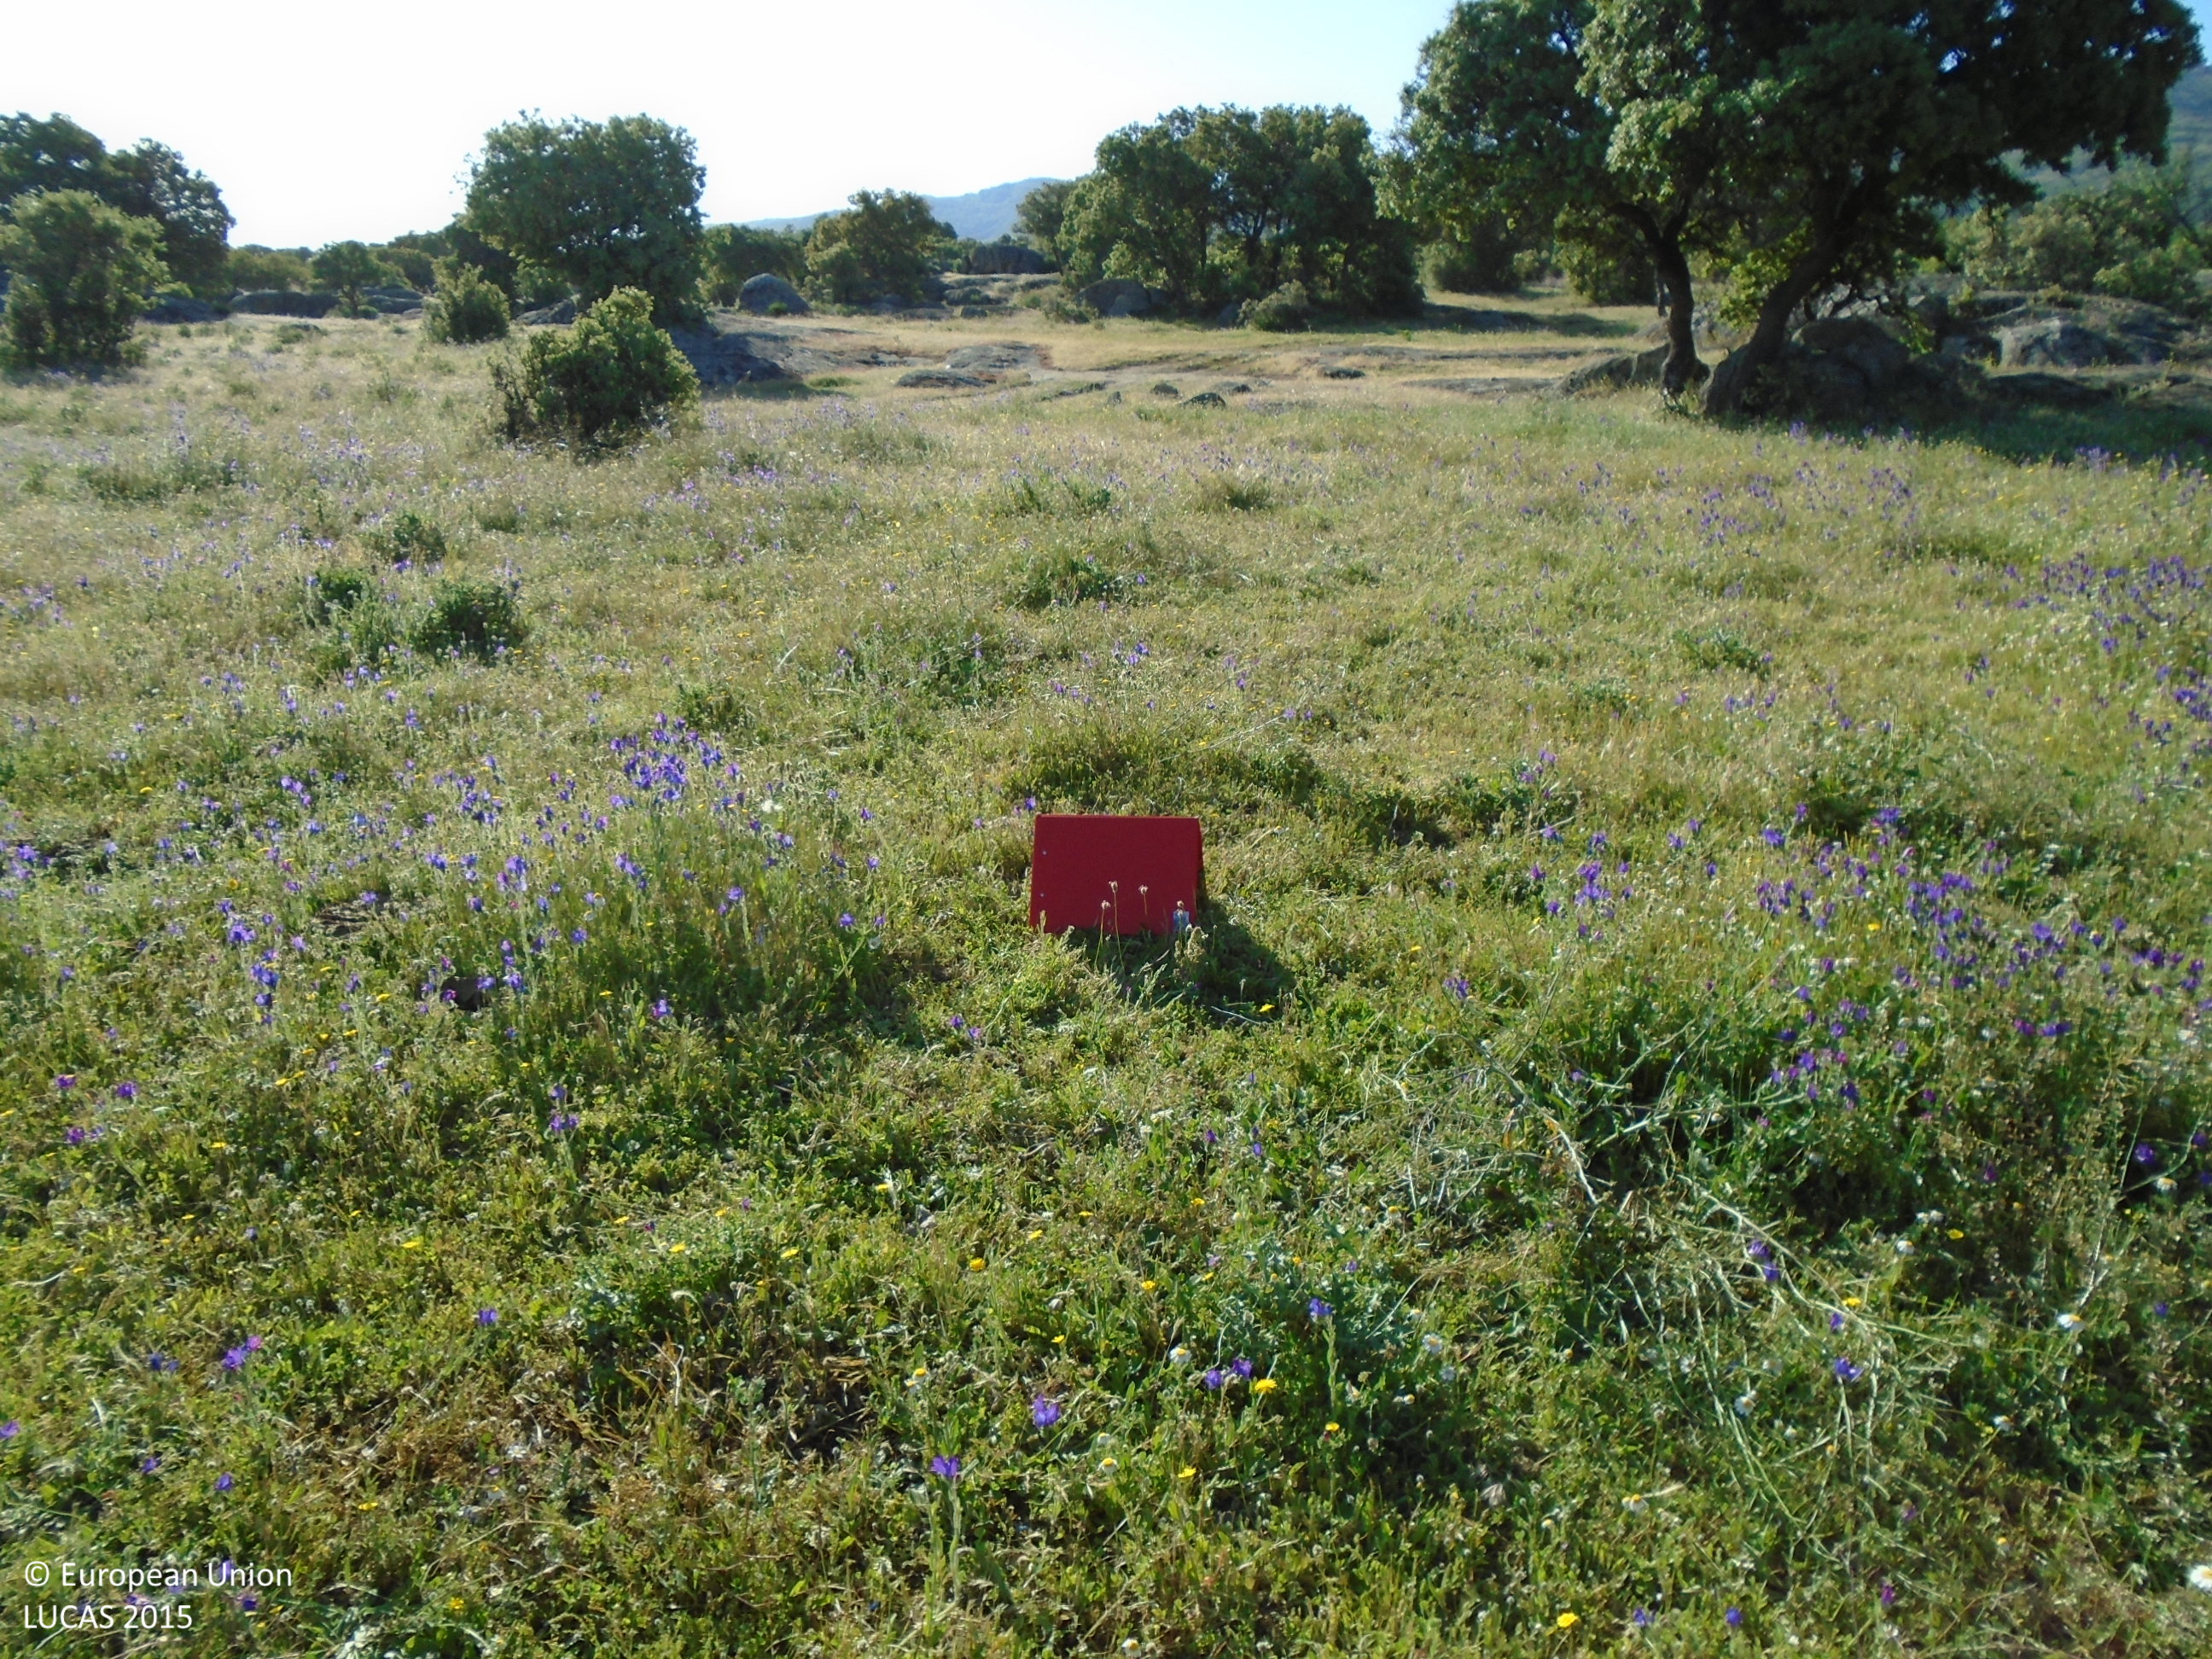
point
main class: Woodland
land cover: Broadleaved woodland
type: broadleaved evergreen forest
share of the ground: 10 - 25 %
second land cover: Spontaneously vegetated surfaces
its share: > 75 %
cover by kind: herbaceous plants 80 %, broadleaved forest trees 15 %, consolidated bare surface 5 %
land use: Forestry
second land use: Agriculture (excluding fallow land and kitchen gardens)
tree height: > 5 m
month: May
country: ES
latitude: 39.5981
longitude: -4.1819
